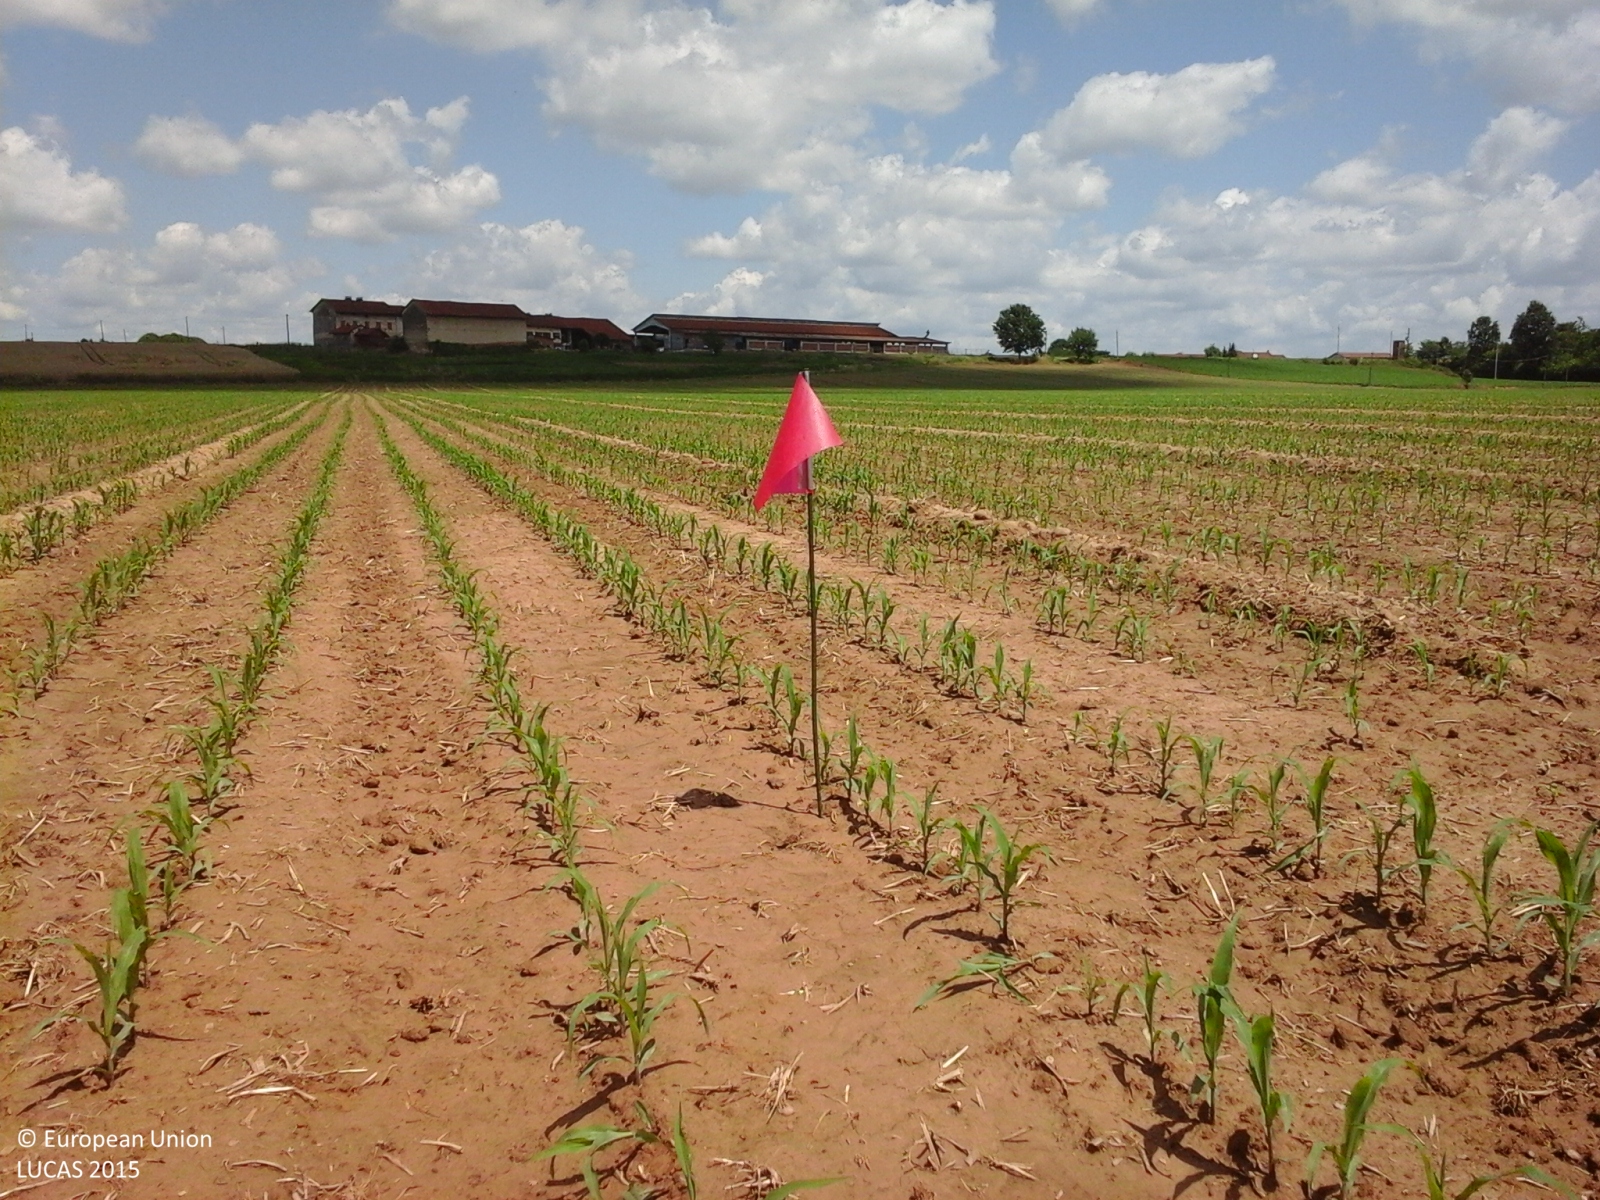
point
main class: Cropland
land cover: Maize
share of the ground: < 10 %
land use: Agriculture (excluding fallow land and kitchen gardens)
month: June
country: IT
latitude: 44.8867
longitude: 7.8137
